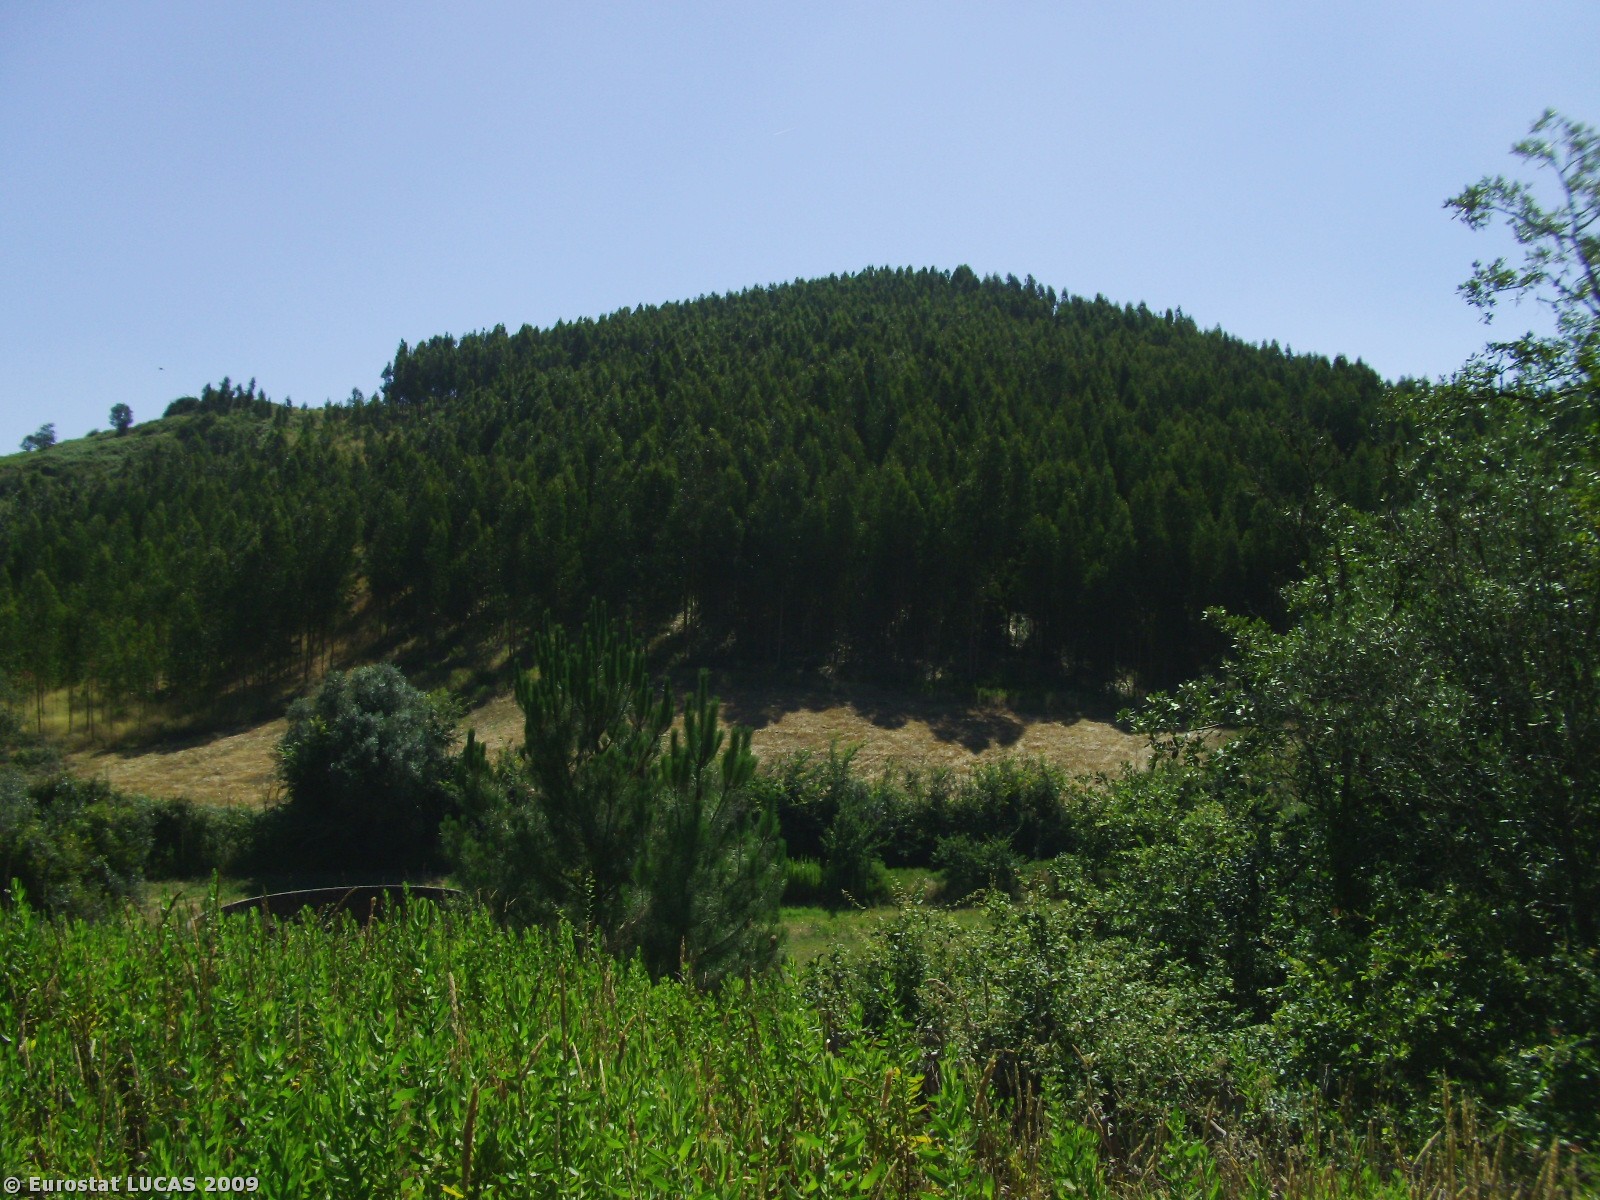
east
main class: Grassland
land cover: Spontaneously vegetated surfaces
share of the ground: > 75 %
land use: Fallow land
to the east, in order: Spontaneously vegetated surfaces; Temporary grasslands; Shruby margins; Temporary grasslands; Shruby margins; Rivers and streams; Shruby margins; Broadleaved woodland
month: July
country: PT
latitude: 38.9258
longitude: -9.2890
